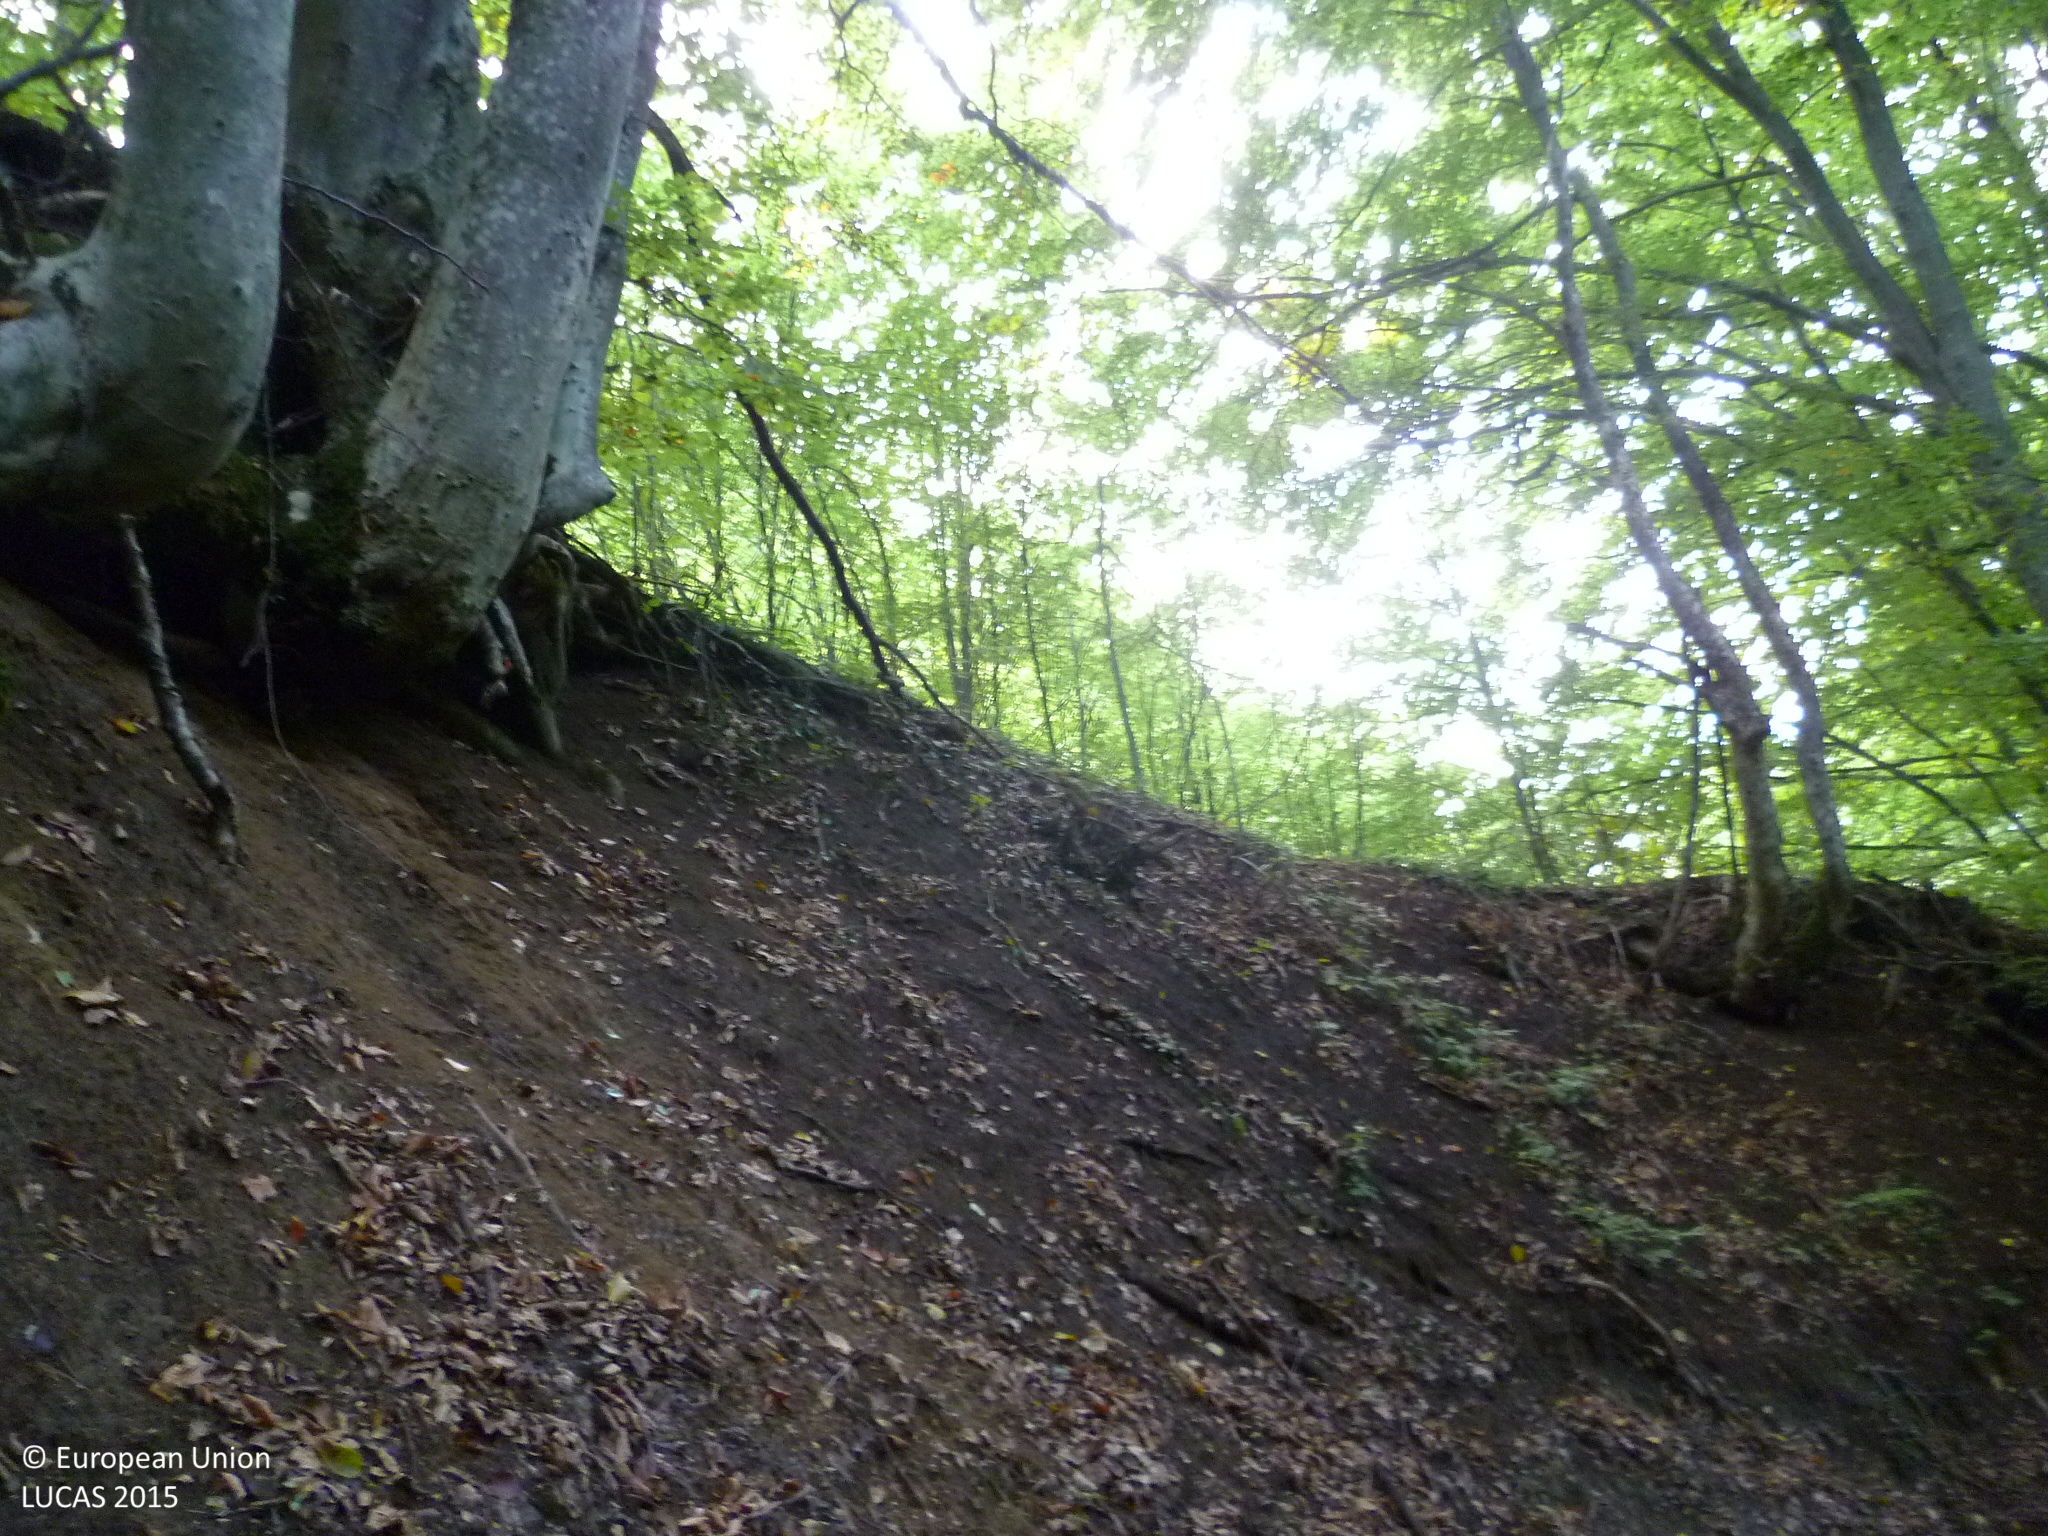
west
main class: Woodland
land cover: Broadleaved woodland
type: beech forest
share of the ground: 50 - 75 %
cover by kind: broadleaved forest trees 70 %, unconsolidated bare surface 20 %, lichens and mosses 10 %
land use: Forestry
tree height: > 5 m
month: October
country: BG
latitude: 42.8559
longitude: 22.6937
